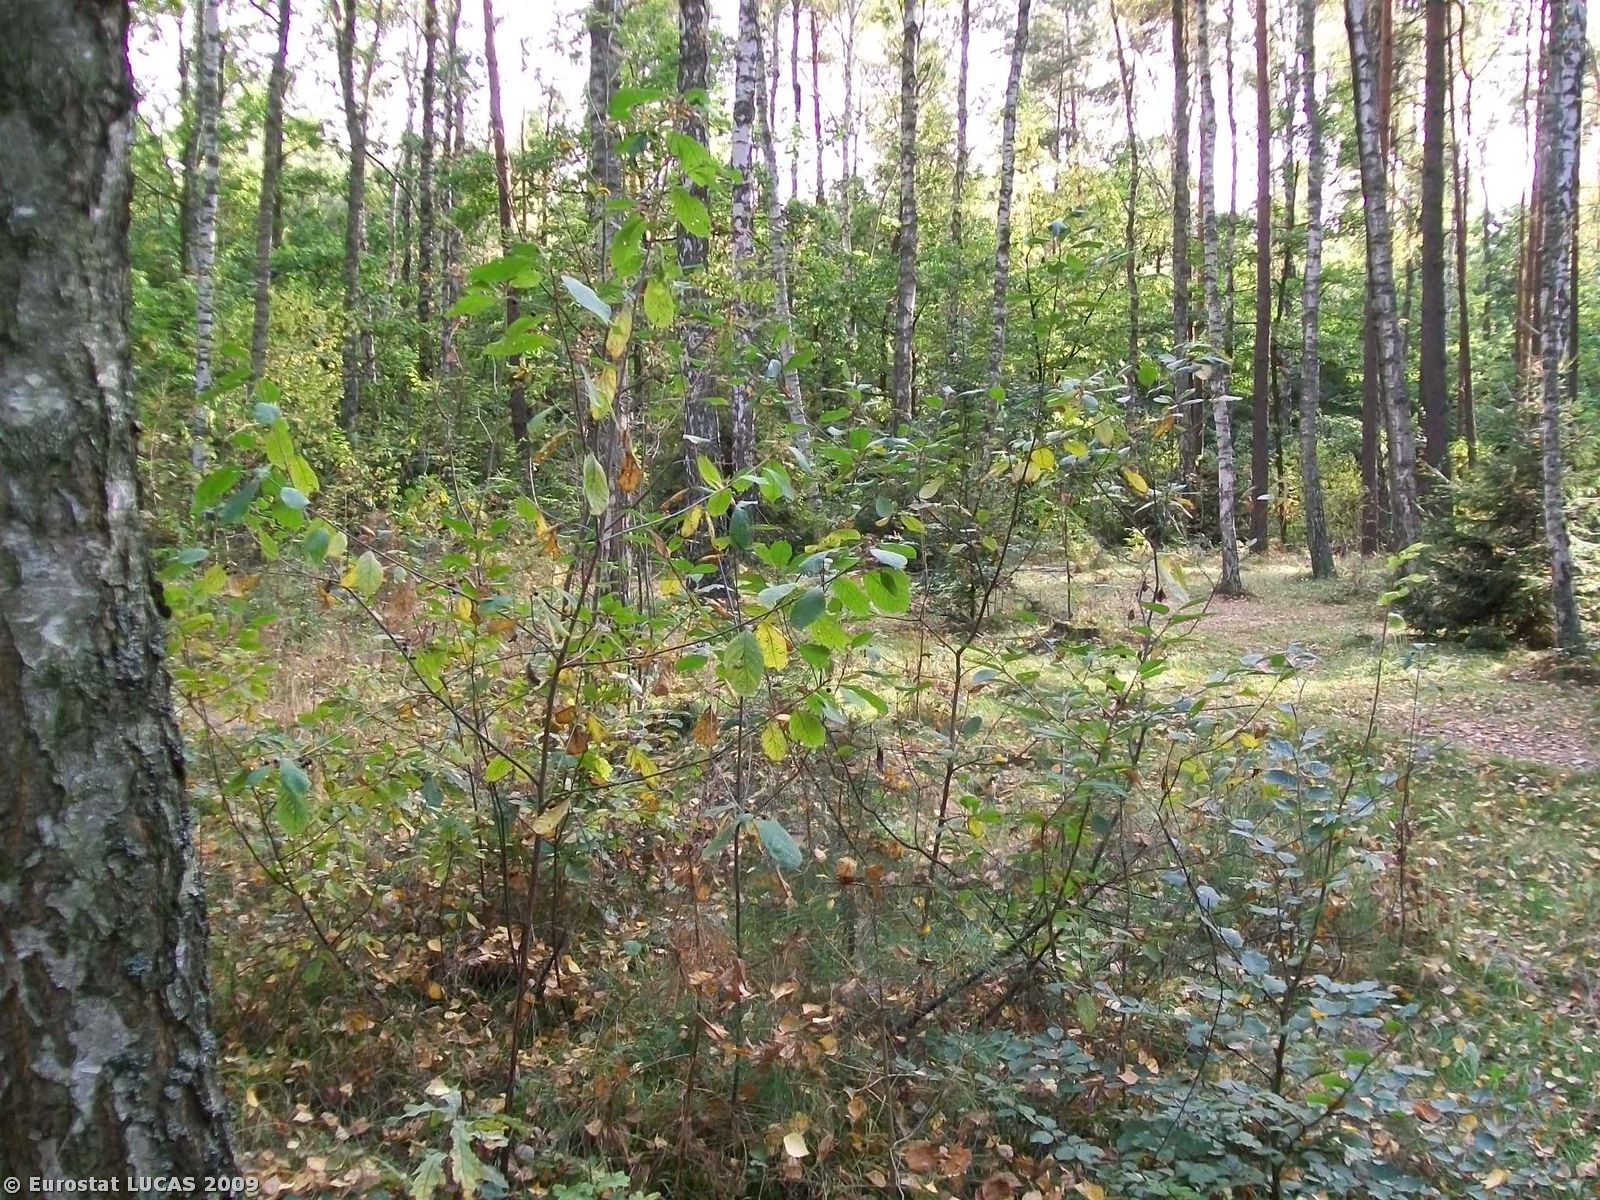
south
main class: Woodland
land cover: Mixed woodland
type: hemiboreal forest and nemoral coniferous forest and mixed broadleaved-coniferous forest
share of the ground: > 75 %
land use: Nature reserves
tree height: > 5 m
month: September
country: PL
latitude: 52.1121
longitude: 21.0701
